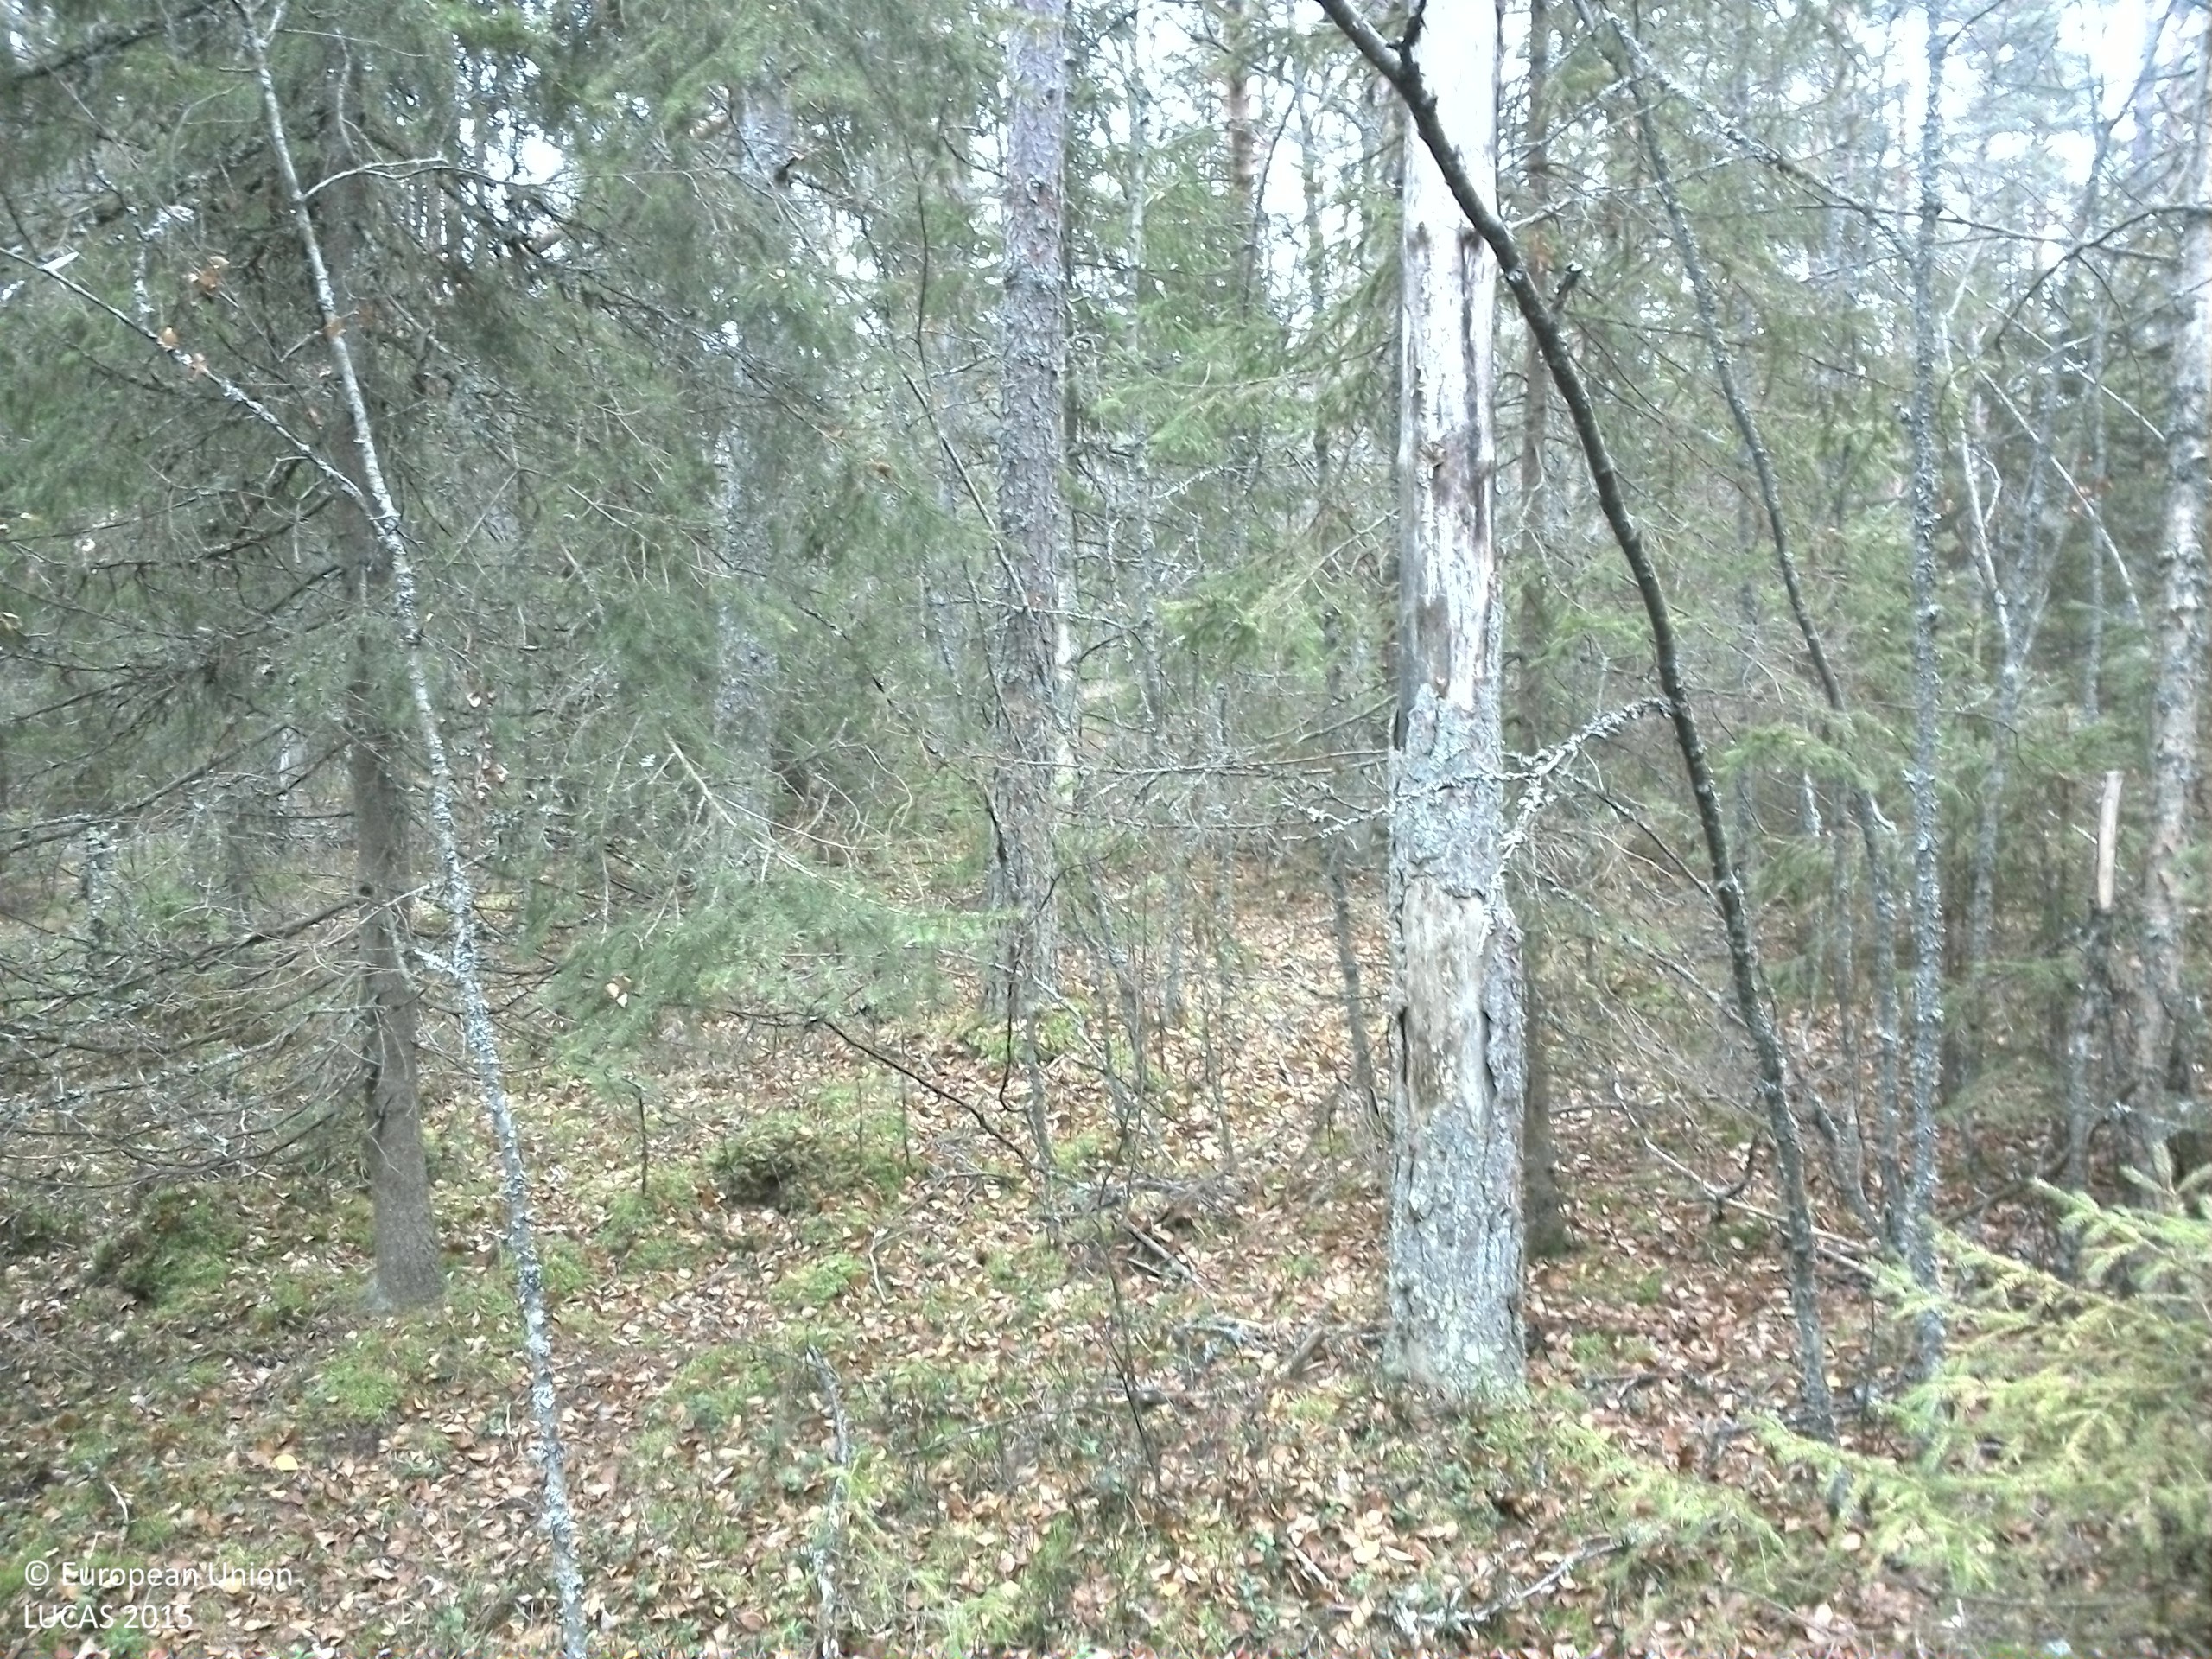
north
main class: Woodland
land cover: Spruce dominated mixed woodland
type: boreal forest
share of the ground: 50 - 75 %
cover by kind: coniferous forest trees 45 %, broadleaved forest trees 25 %, shrubs 10 %, herbaceous plants 10 %, lichens and mosses 10 %
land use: Forestry
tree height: > 5 m
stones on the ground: < 10 %
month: November
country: SE
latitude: 57.5946
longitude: 14.7638
